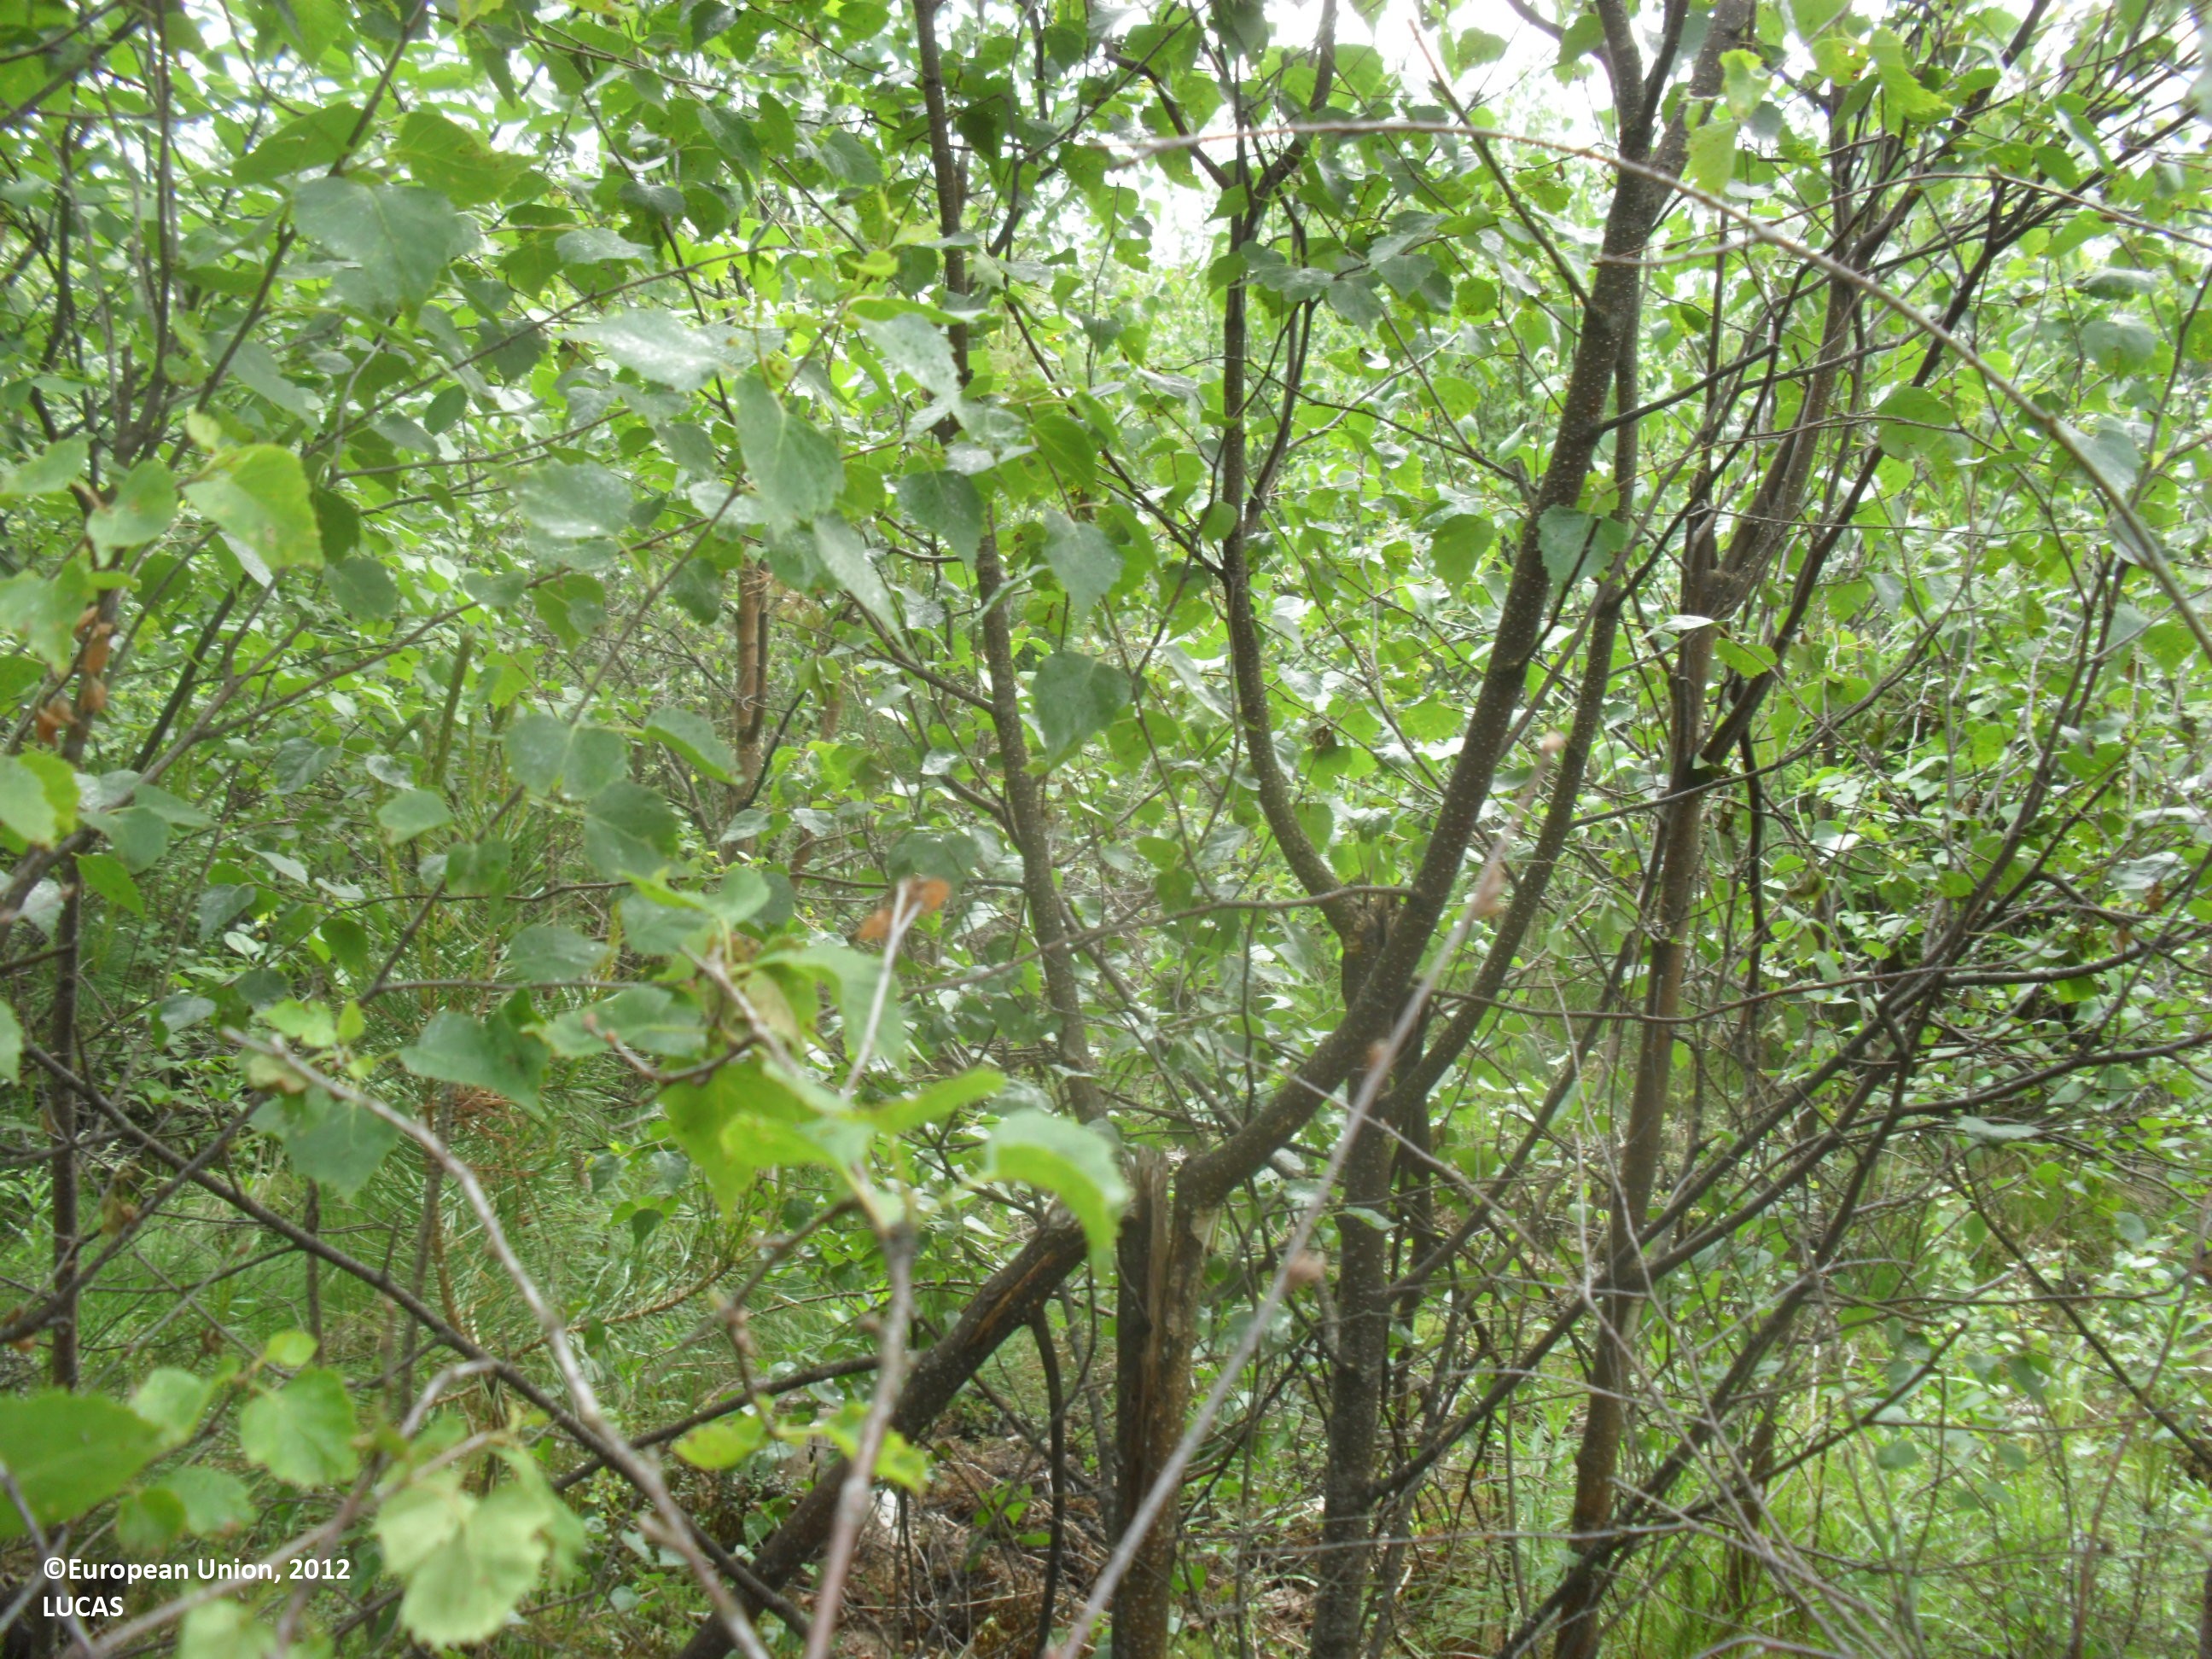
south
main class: Woodland
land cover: Other mixed woodland
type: boreal forest
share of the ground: 50 - 75 %
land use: Forestry
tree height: < 5 m
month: June
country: FI
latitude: 63.4594
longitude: 23.4002
